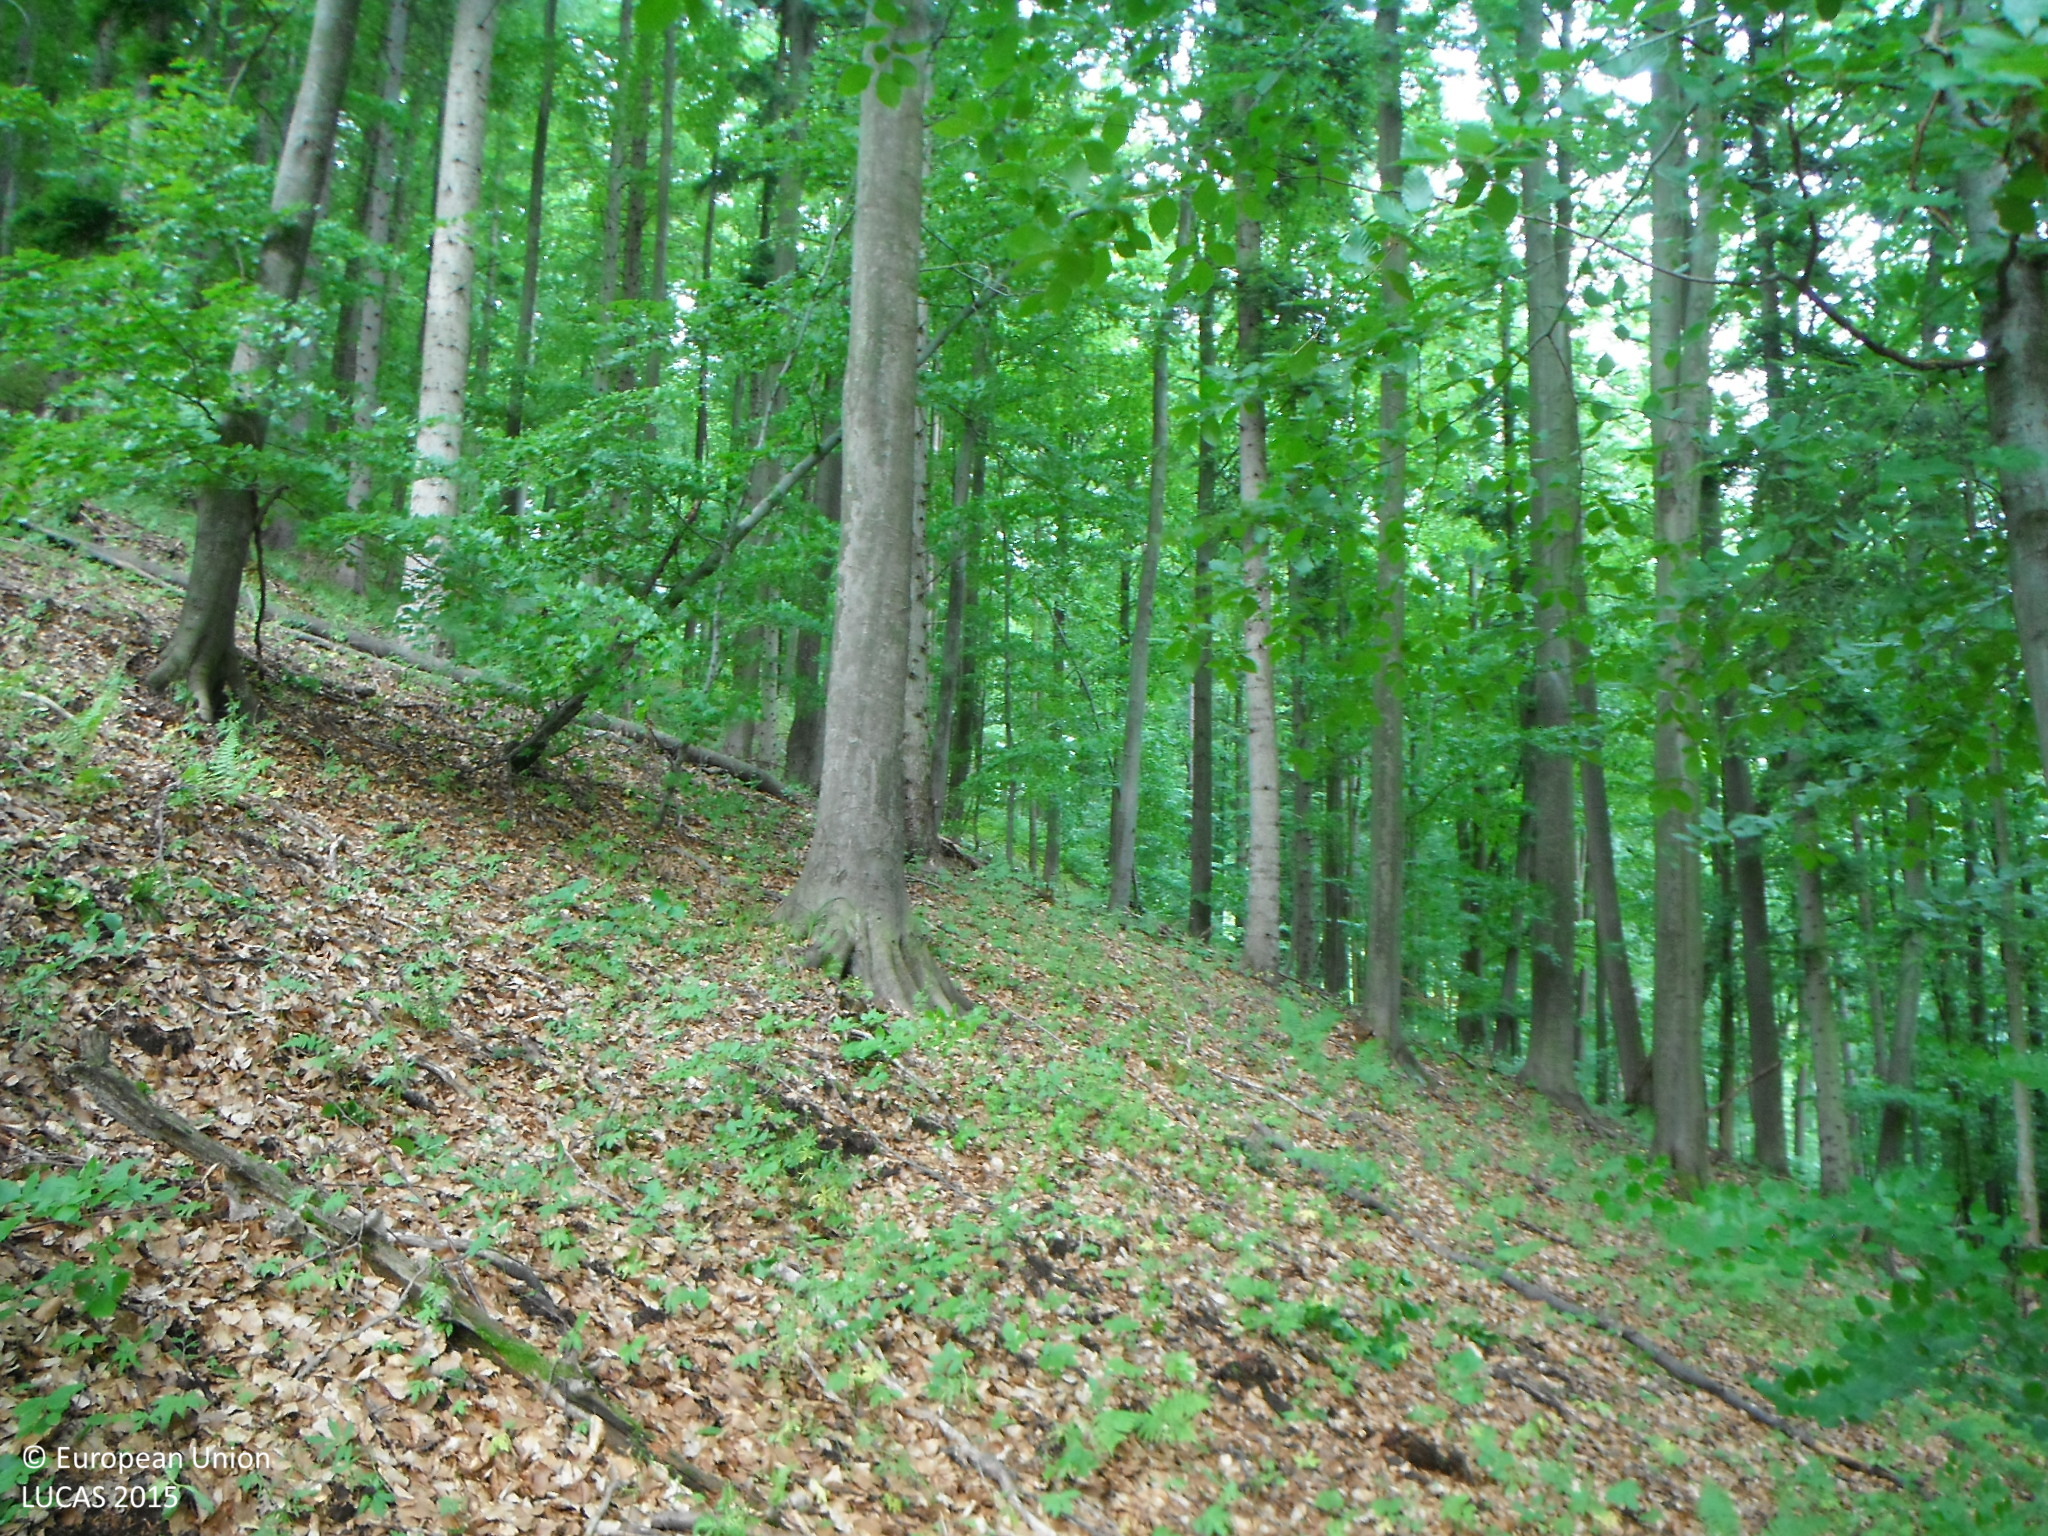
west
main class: Woodland
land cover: Other mixed woodland
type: mountainous beech forest
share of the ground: > 75 %
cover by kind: broadleaved forest trees 75 %, coniferous forest trees 25 %
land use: Forestry
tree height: > 5 m
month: May
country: SK
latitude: 48.4913
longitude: 18.9645
